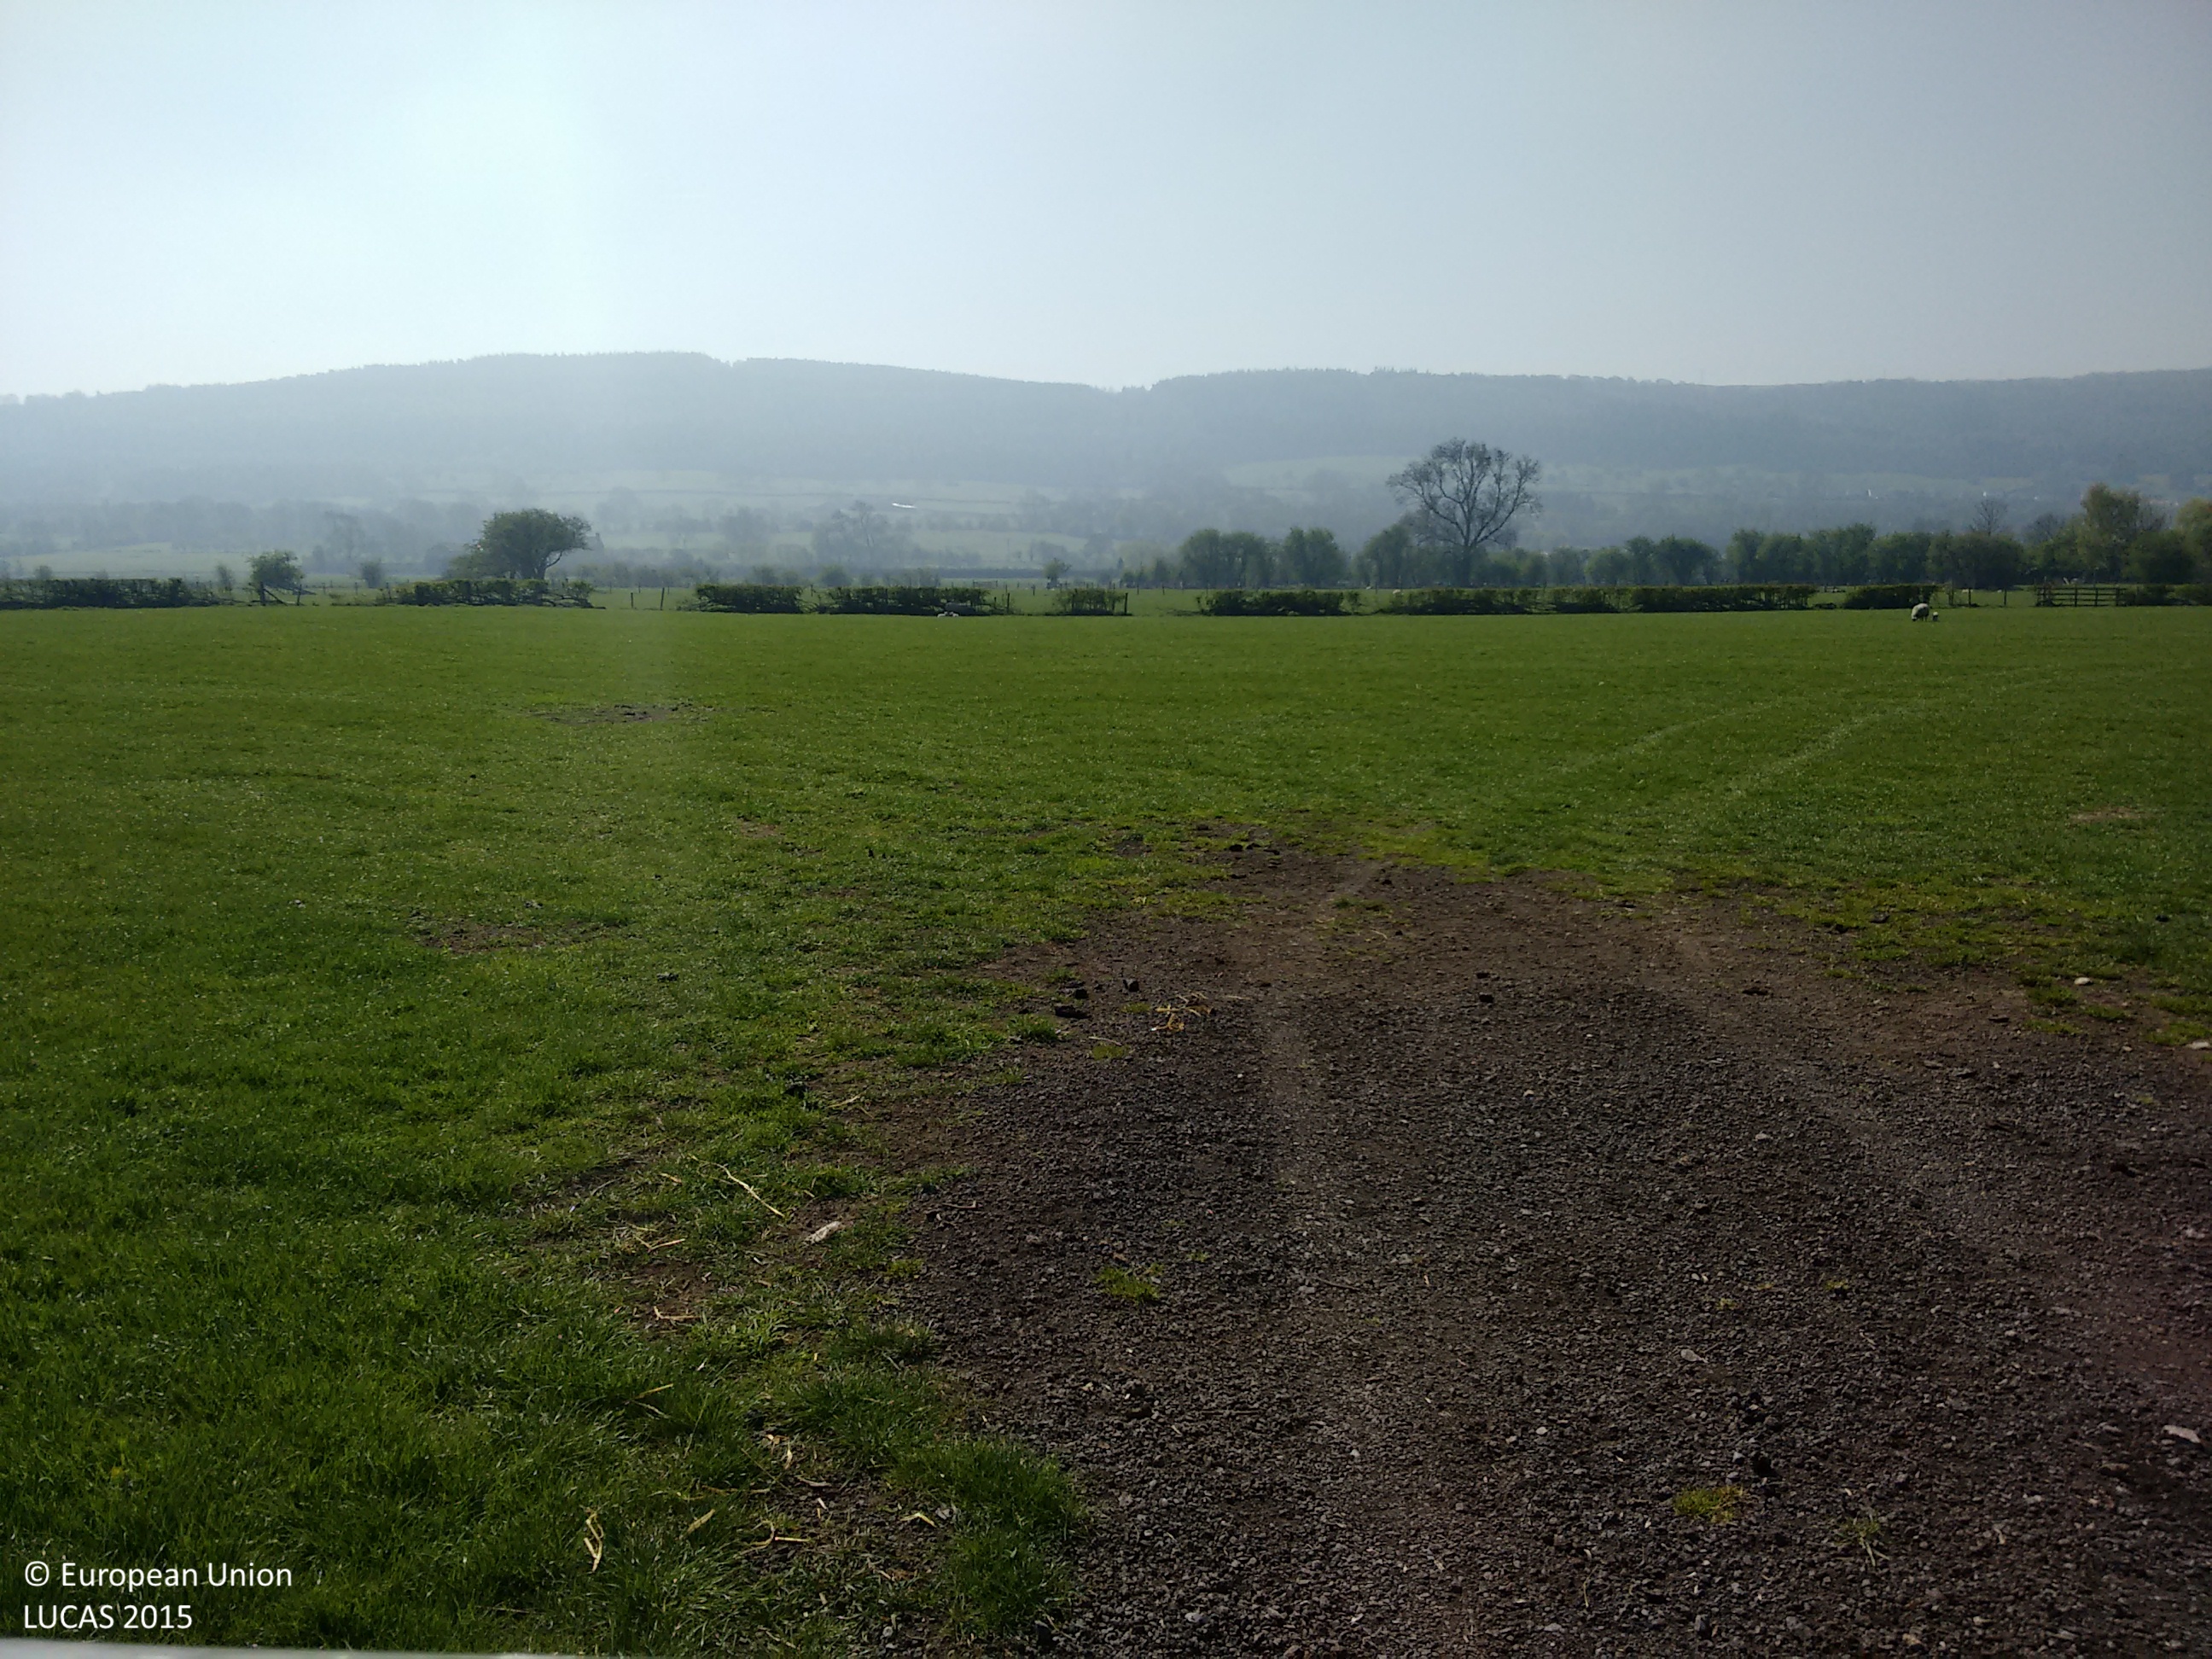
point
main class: Grassland
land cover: Grassland without tree/shrub cover
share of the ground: > 75 %
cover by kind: herbaceous plants 100 %
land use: Agriculture (excluding fallow land and kitchen gardens)
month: April
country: GB
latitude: 53.9081
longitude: -1.6664
